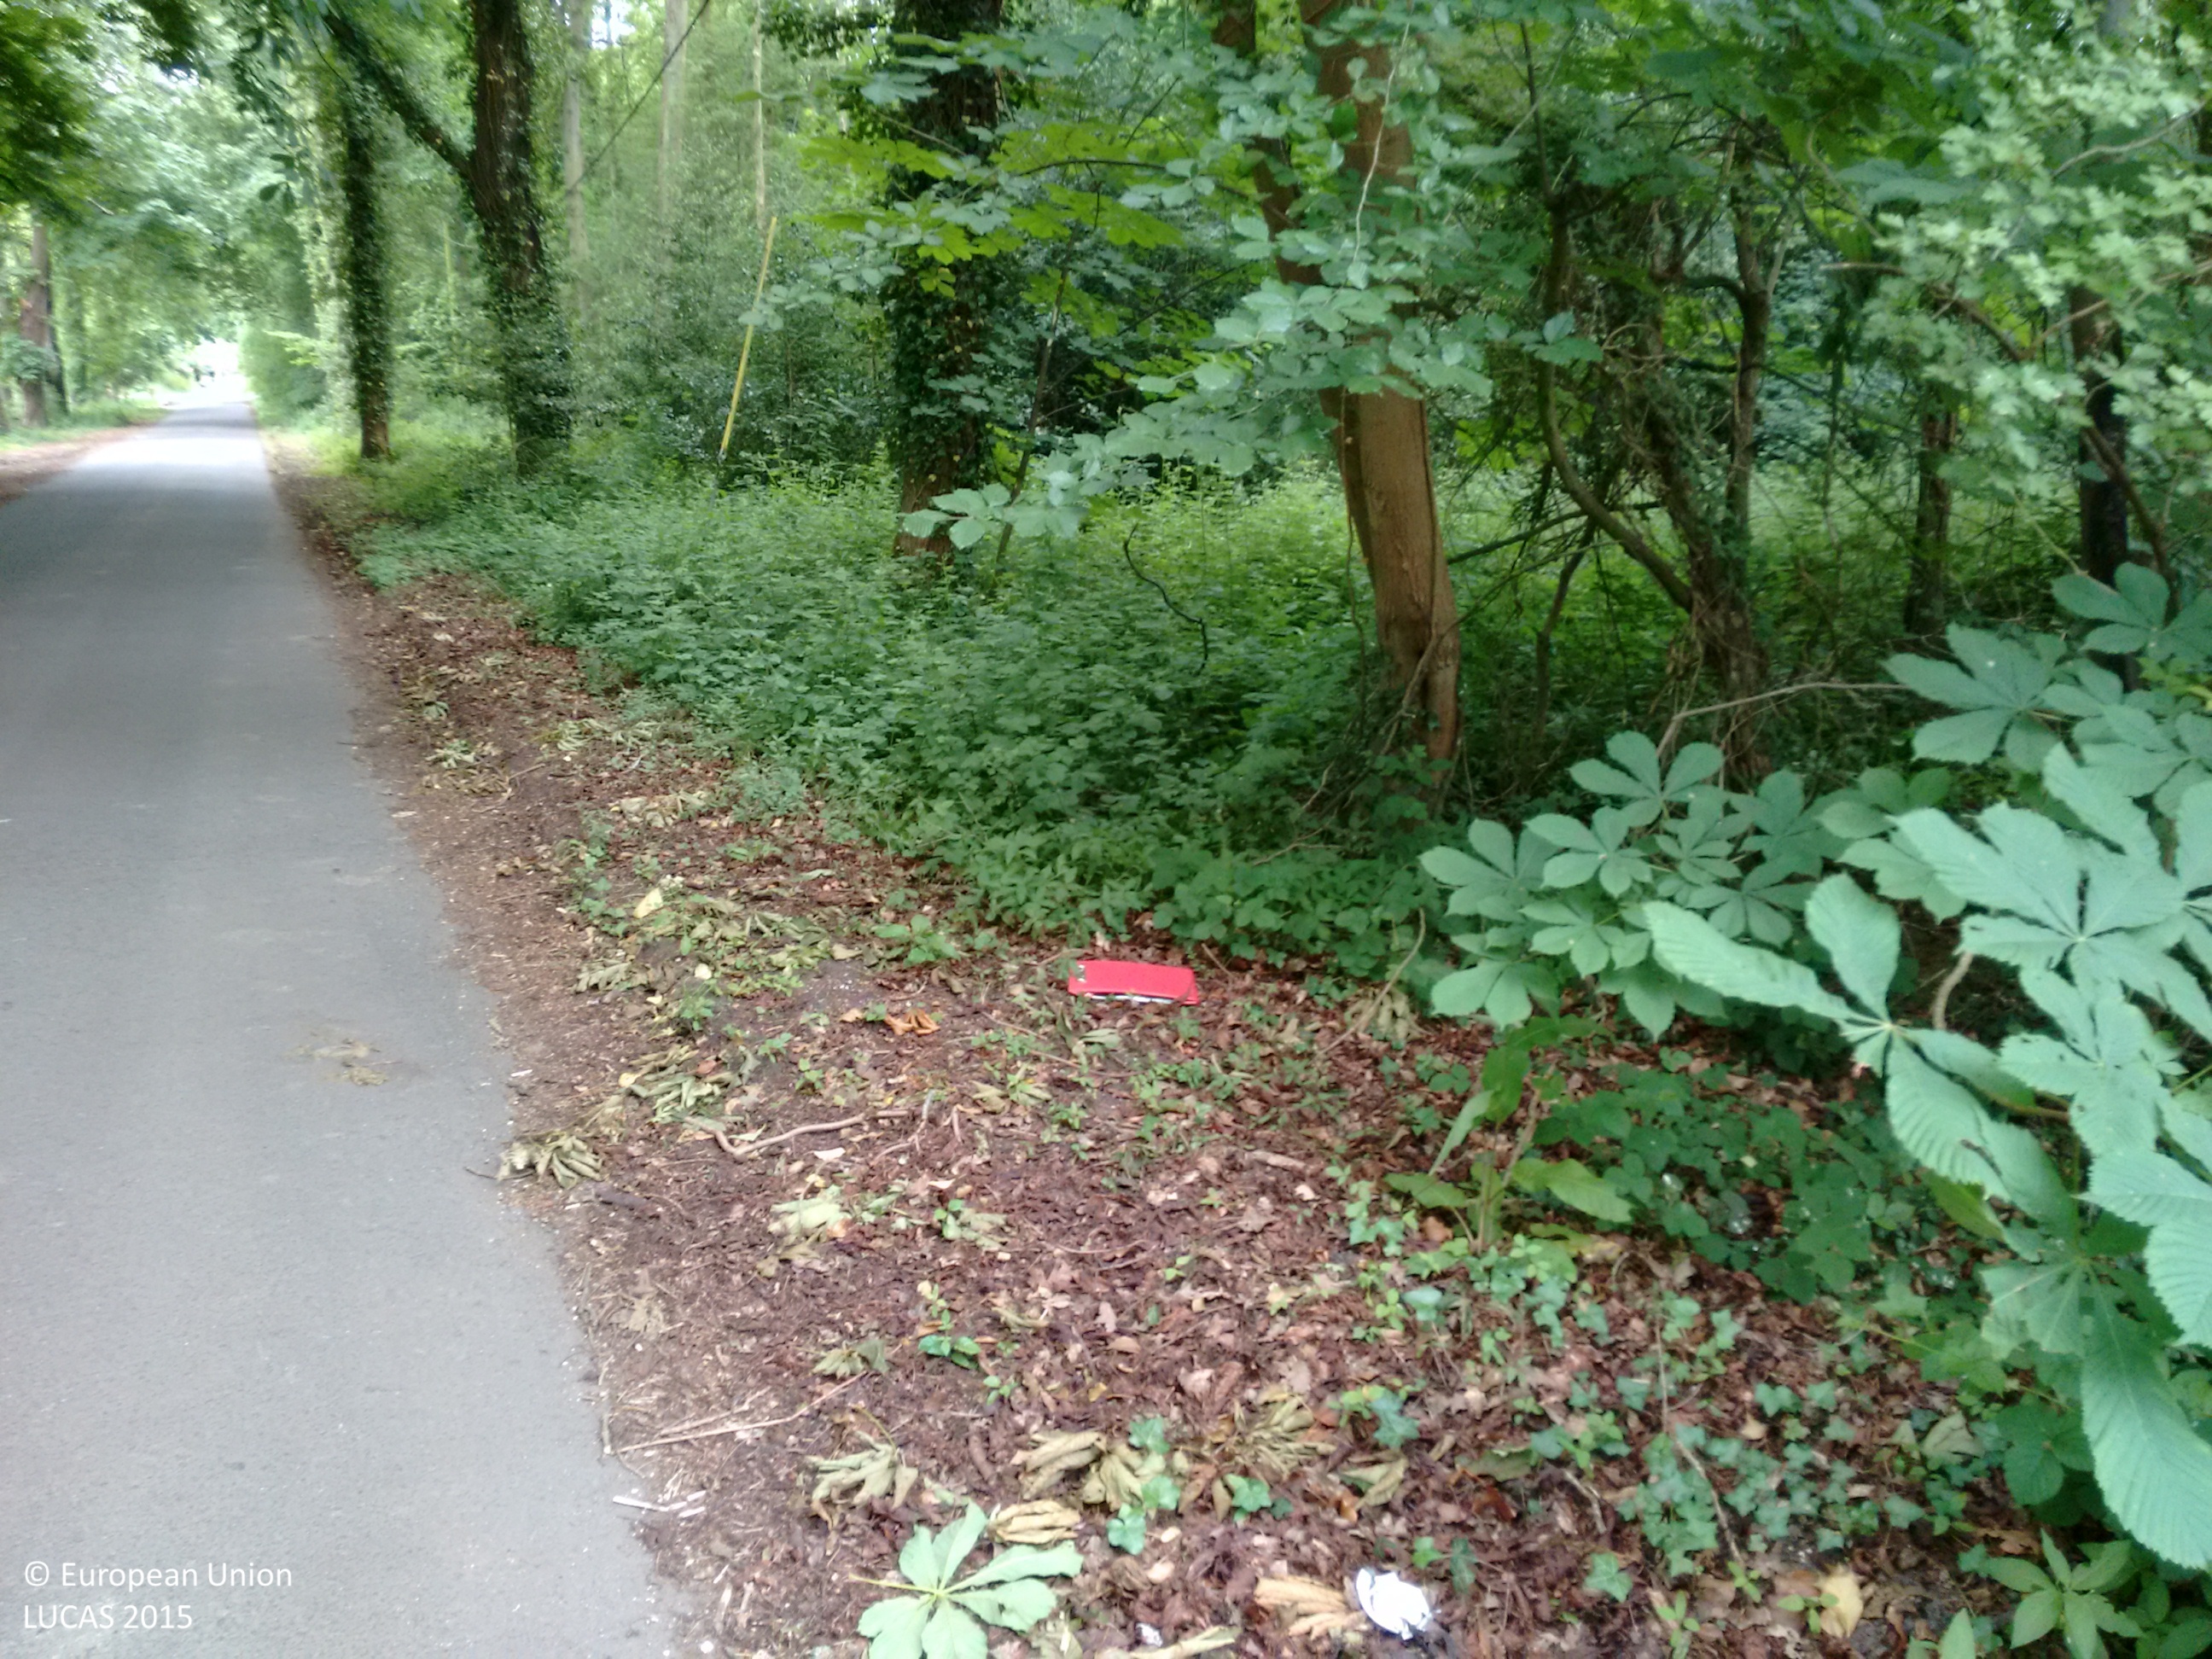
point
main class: Woodland
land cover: Broadleaved woodland
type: mesophytic deciduous forest
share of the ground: > 75 %
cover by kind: broadleaved forest trees 80 %, herbaceous plants 20 %
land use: Semi-natural and natural areas not in use
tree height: > 5 m
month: June
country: GB
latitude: 51.3890
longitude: -1.0384
